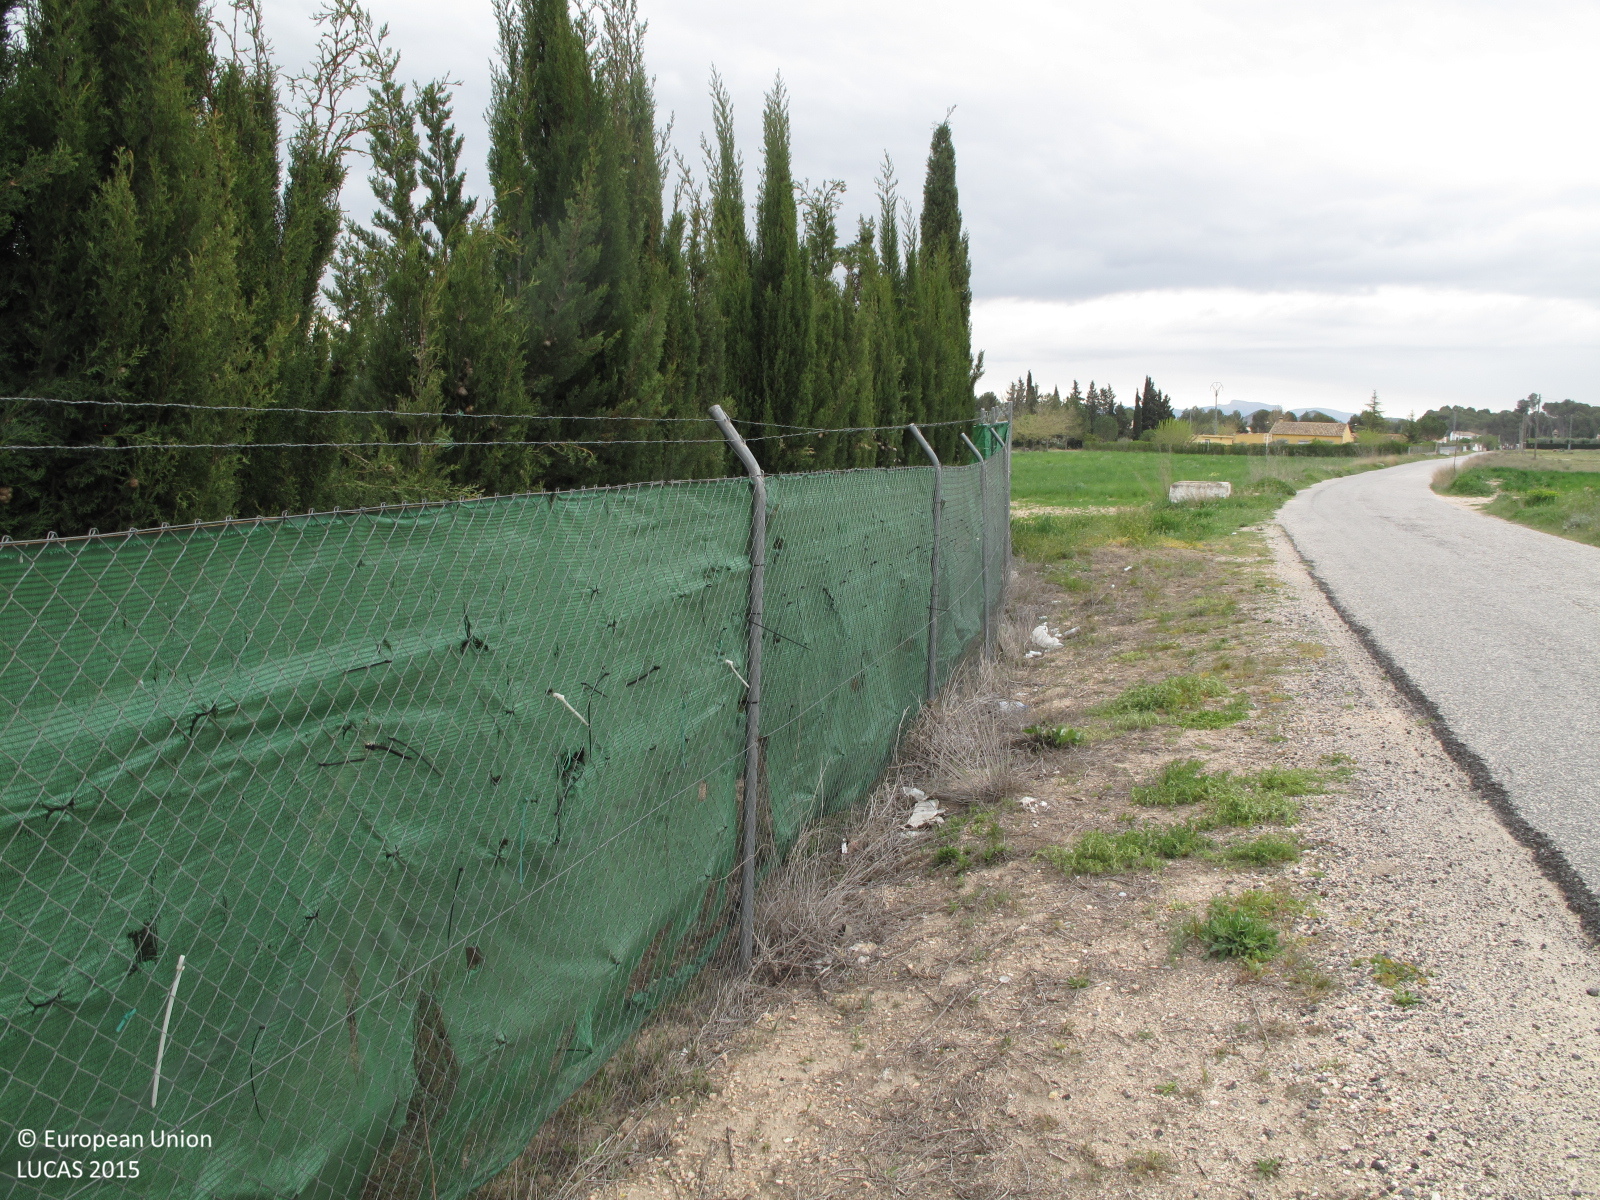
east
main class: Grassland
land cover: Spontaneously vegetated surfaces
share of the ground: 10 - 25 %
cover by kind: consolidated bare surface 75 %, herbaceous plants 25 %
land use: Residential
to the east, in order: Spontaneously vegetated surfaces; Abandoned hedges; Spontaneously vegetated surfaces; Abandoned hedges; Fences; Oats; Vineyards; Electric lines; Vineyards; Grass margins
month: April
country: ES
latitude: 38.6316
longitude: -0.9380
